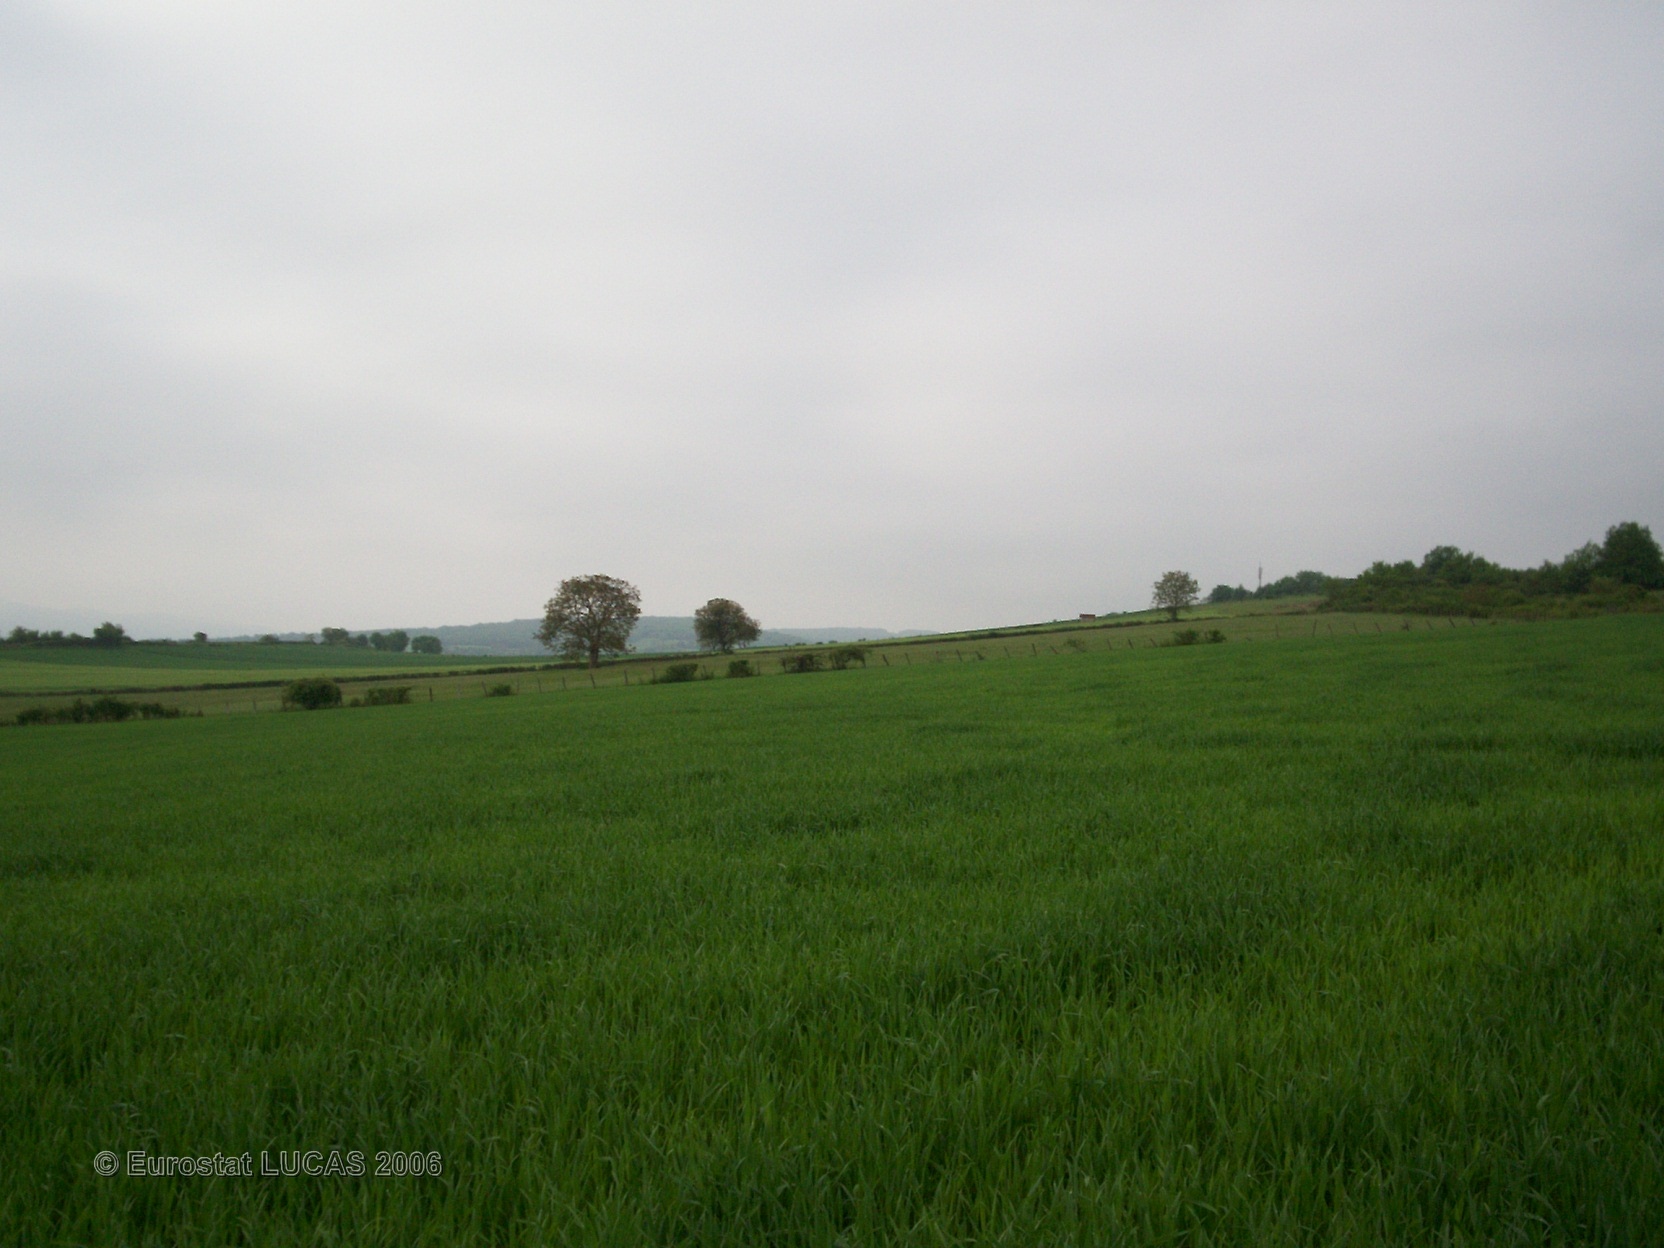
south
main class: Cropland
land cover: Common wheat
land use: Agriculture (excluding fallow land and kitchen gardens)
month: May
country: FR
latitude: 46.5239
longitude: 4.6437
